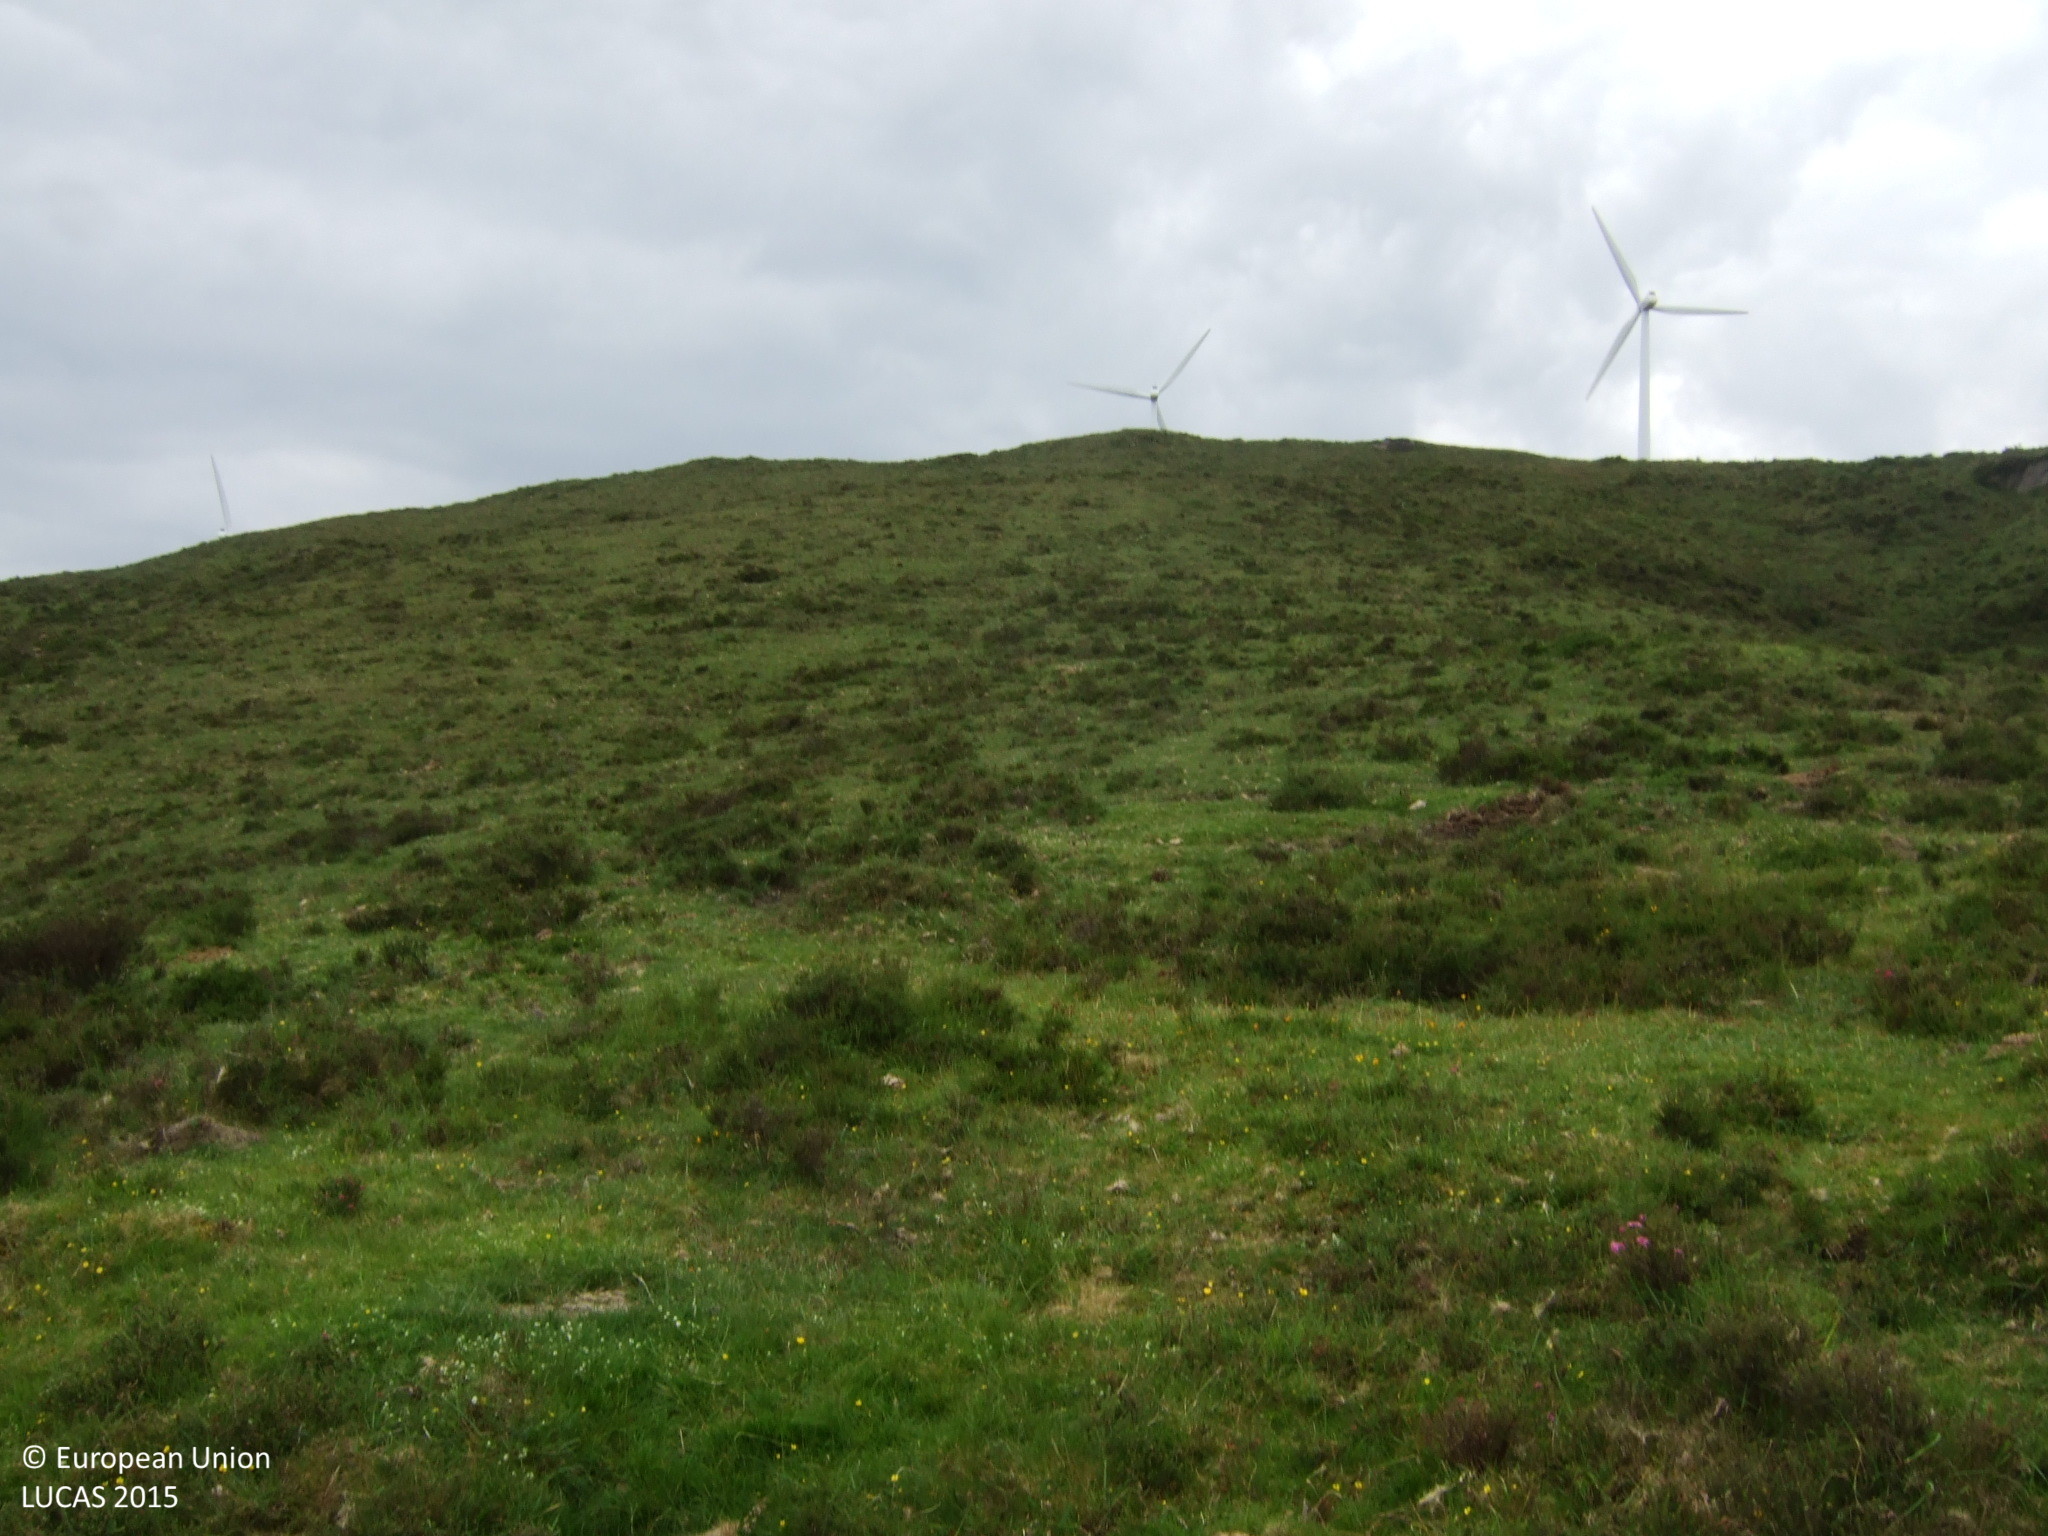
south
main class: Shrubland
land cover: Shrubland without tree cover
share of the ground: 25 - 50 %
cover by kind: herbaceous plants 60 %, shrubs 40 %
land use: Agriculture (excluding fallow land and kitchen gardens)
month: June
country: ES
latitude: 43.4581
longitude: -7.4947
